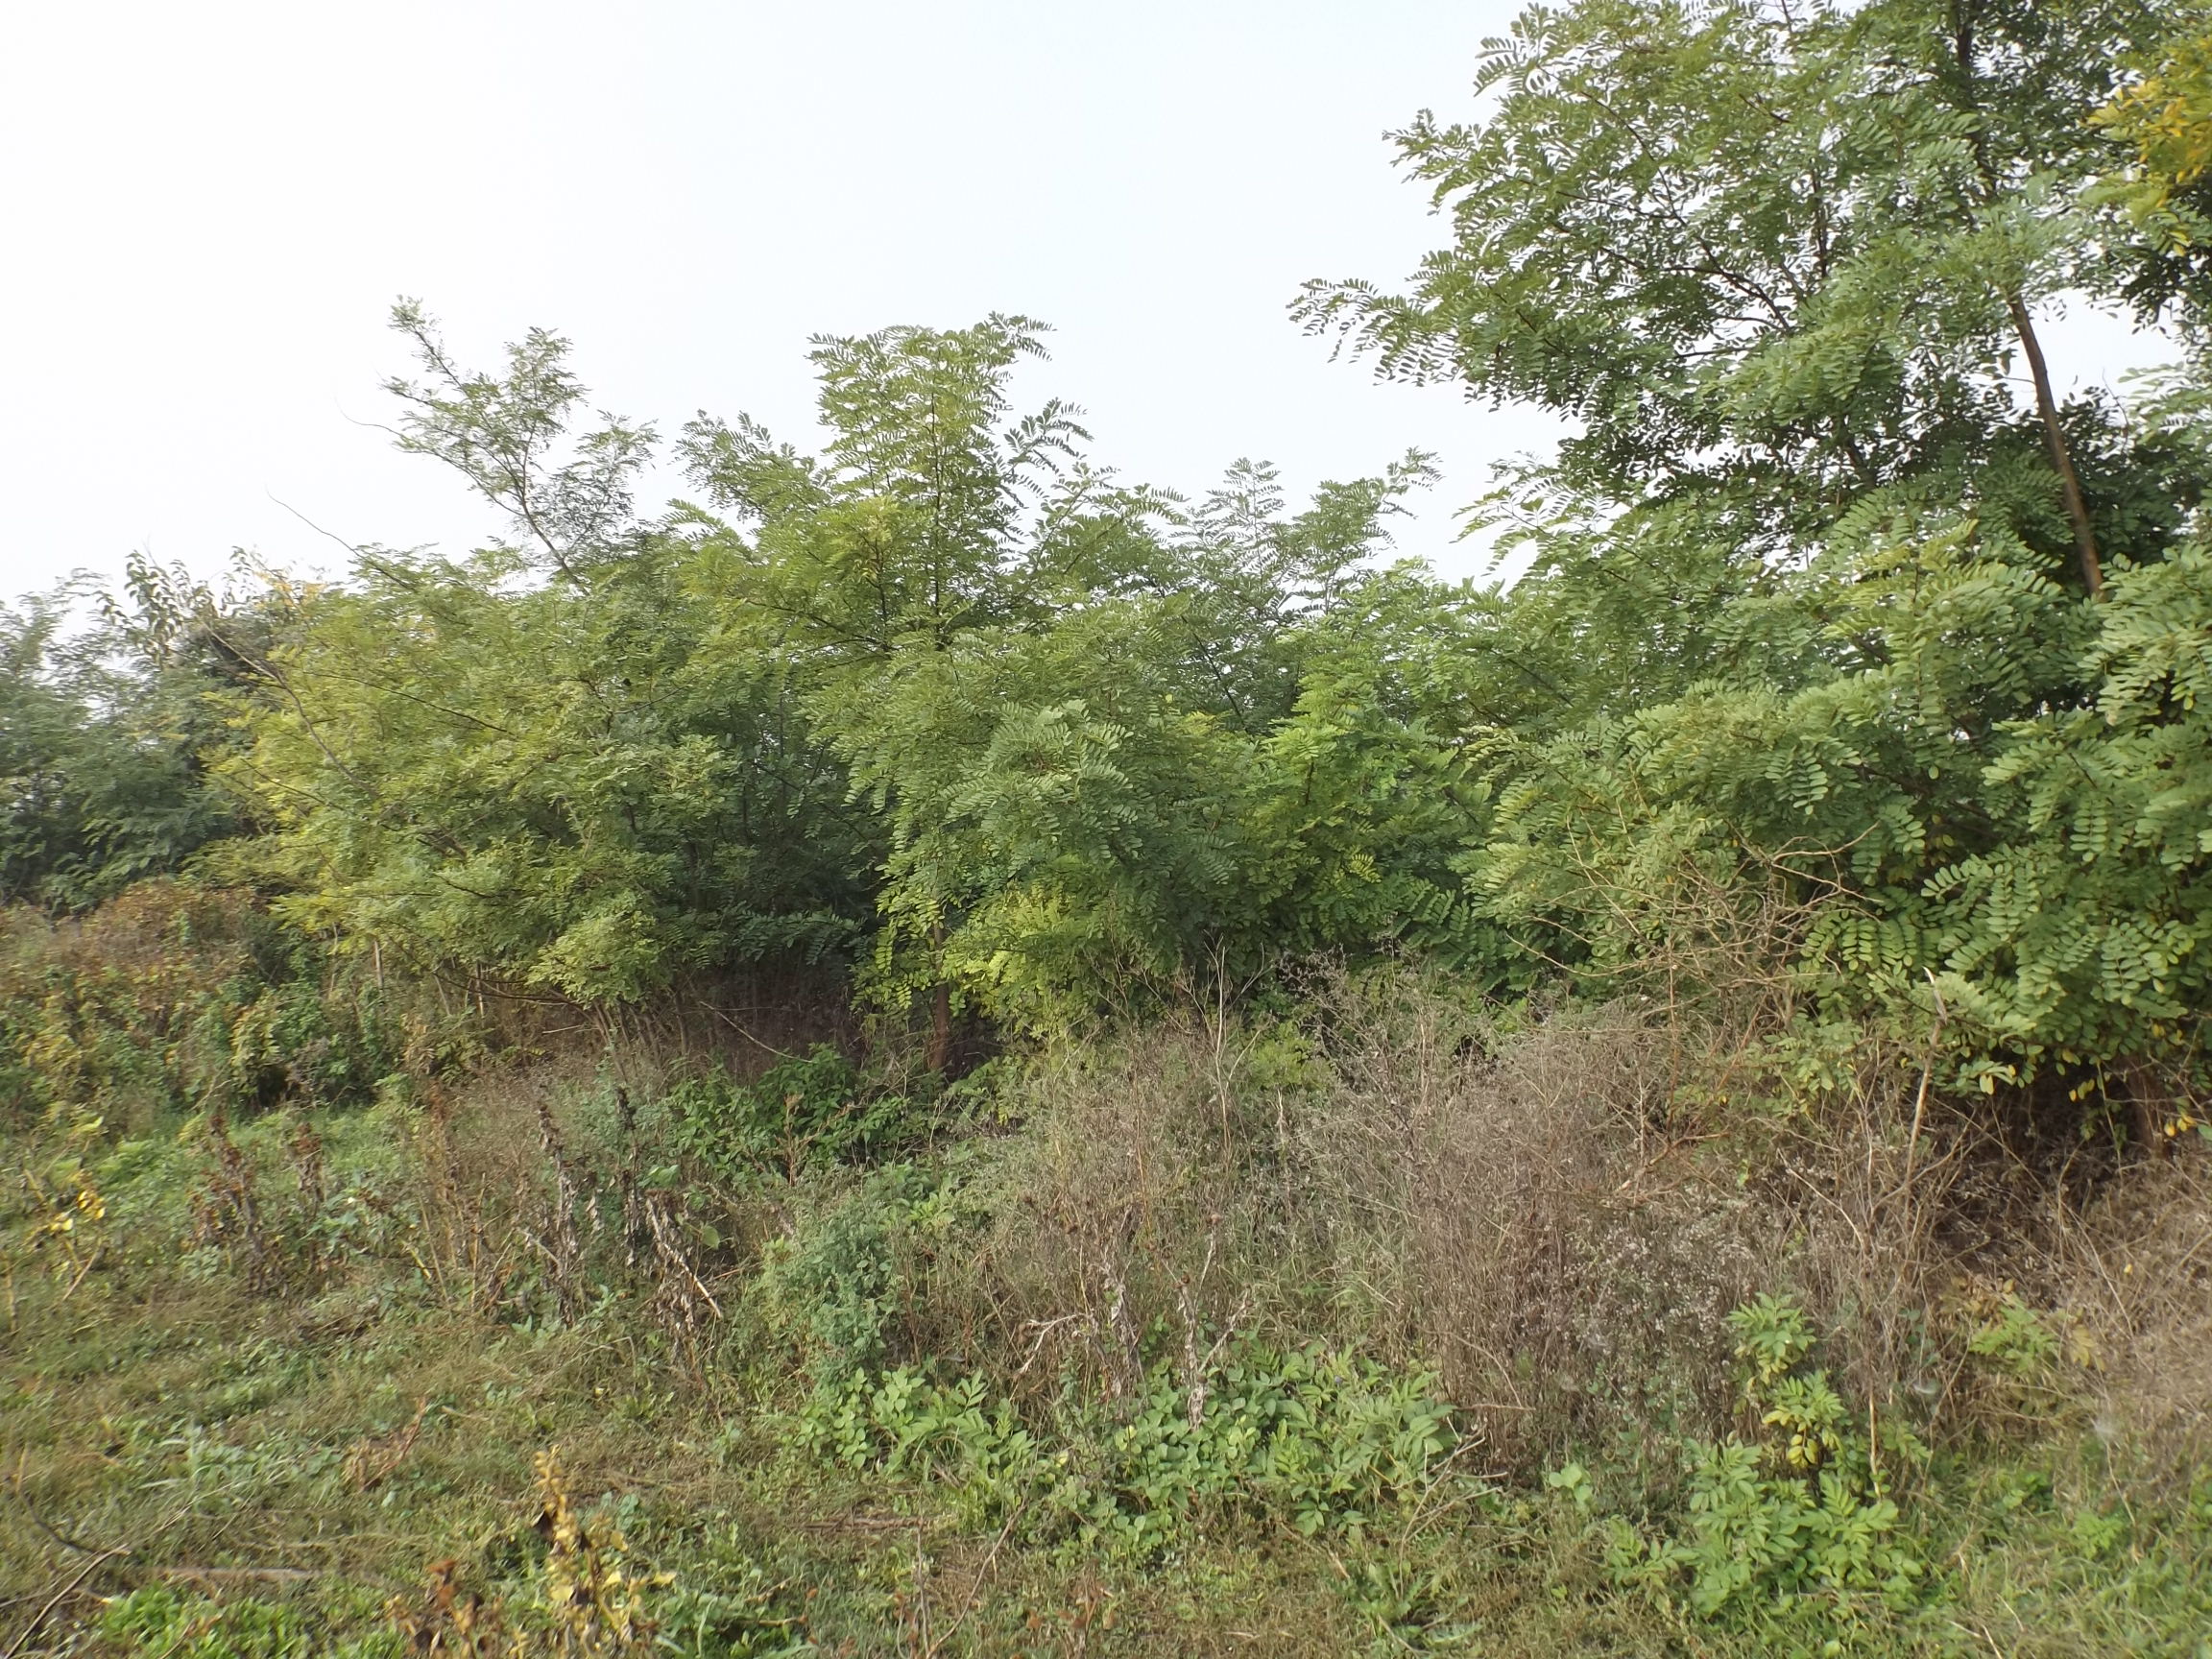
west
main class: Cropland
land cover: Sunflower
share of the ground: < 10 %
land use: Agriculture (excluding fallow land and kitchen gardens)
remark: Harvested field
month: October
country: BG
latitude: 43.1639
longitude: 27.2784
